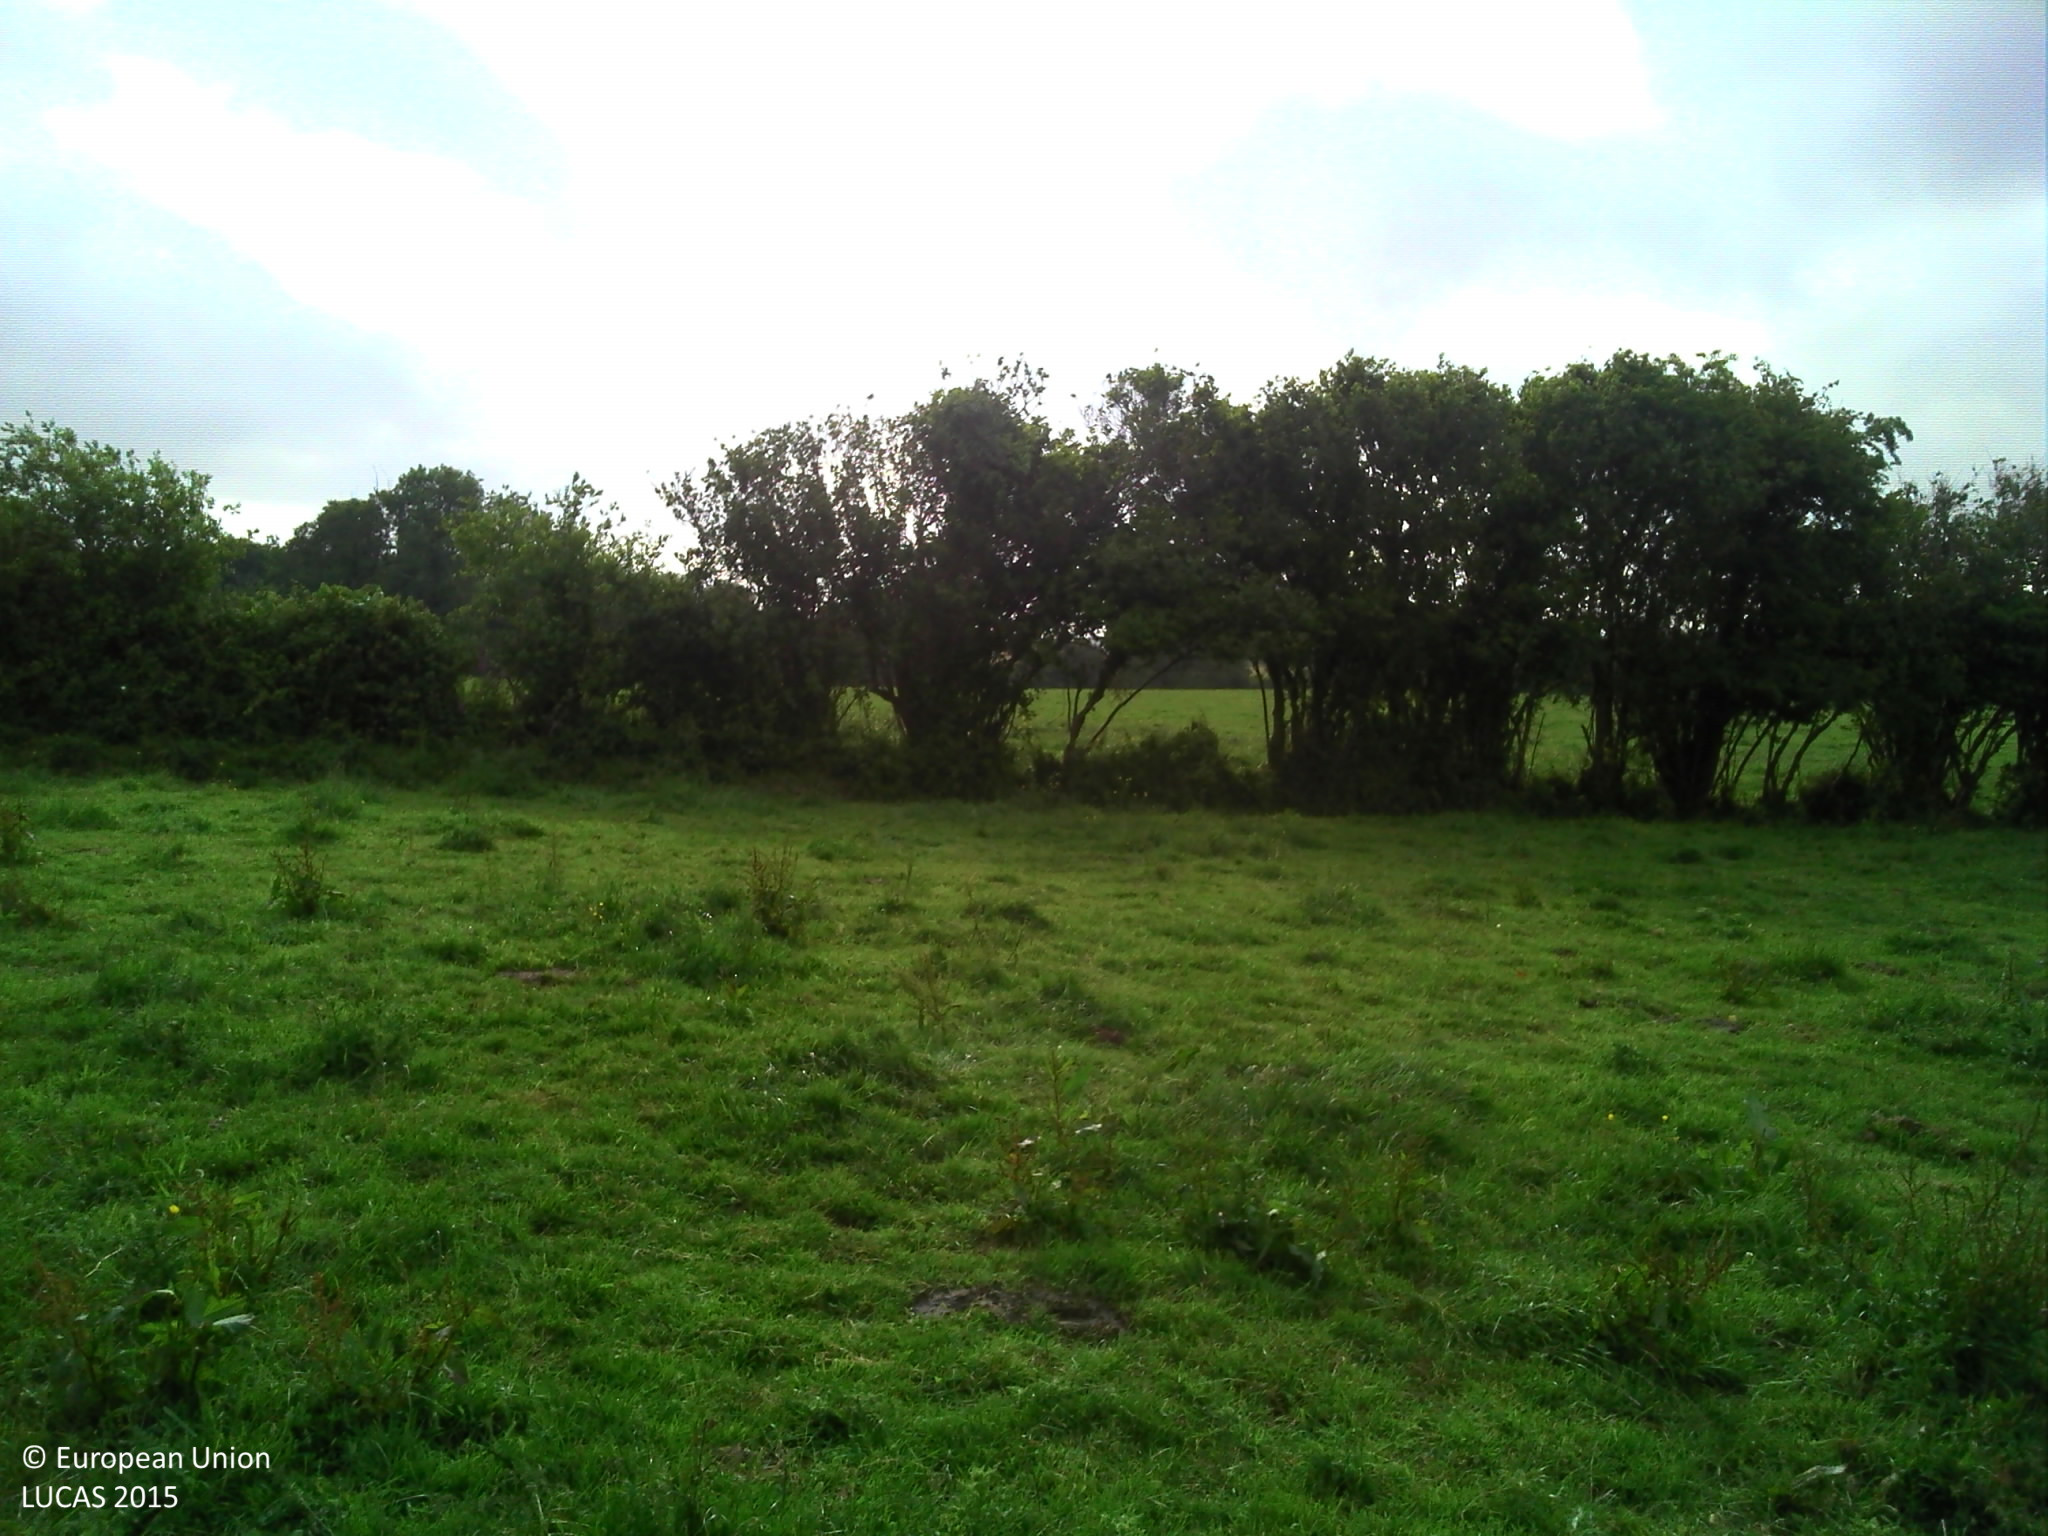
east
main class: Grassland
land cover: Grassland without tree/shrub cover
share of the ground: > 75 %
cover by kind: herbaceous plants 95 %, shrubs 5 %
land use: Agriculture (excluding fallow land and kitchen gardens)
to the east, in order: Grassland without tree/shrub cover; Abandoned hedges; Grassland without tree/shrub cover; Broadleaved woodland; Rivers and streams; Grassland without tree/shrub cover
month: June
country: FR
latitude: 49.5356
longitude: -1.4207
